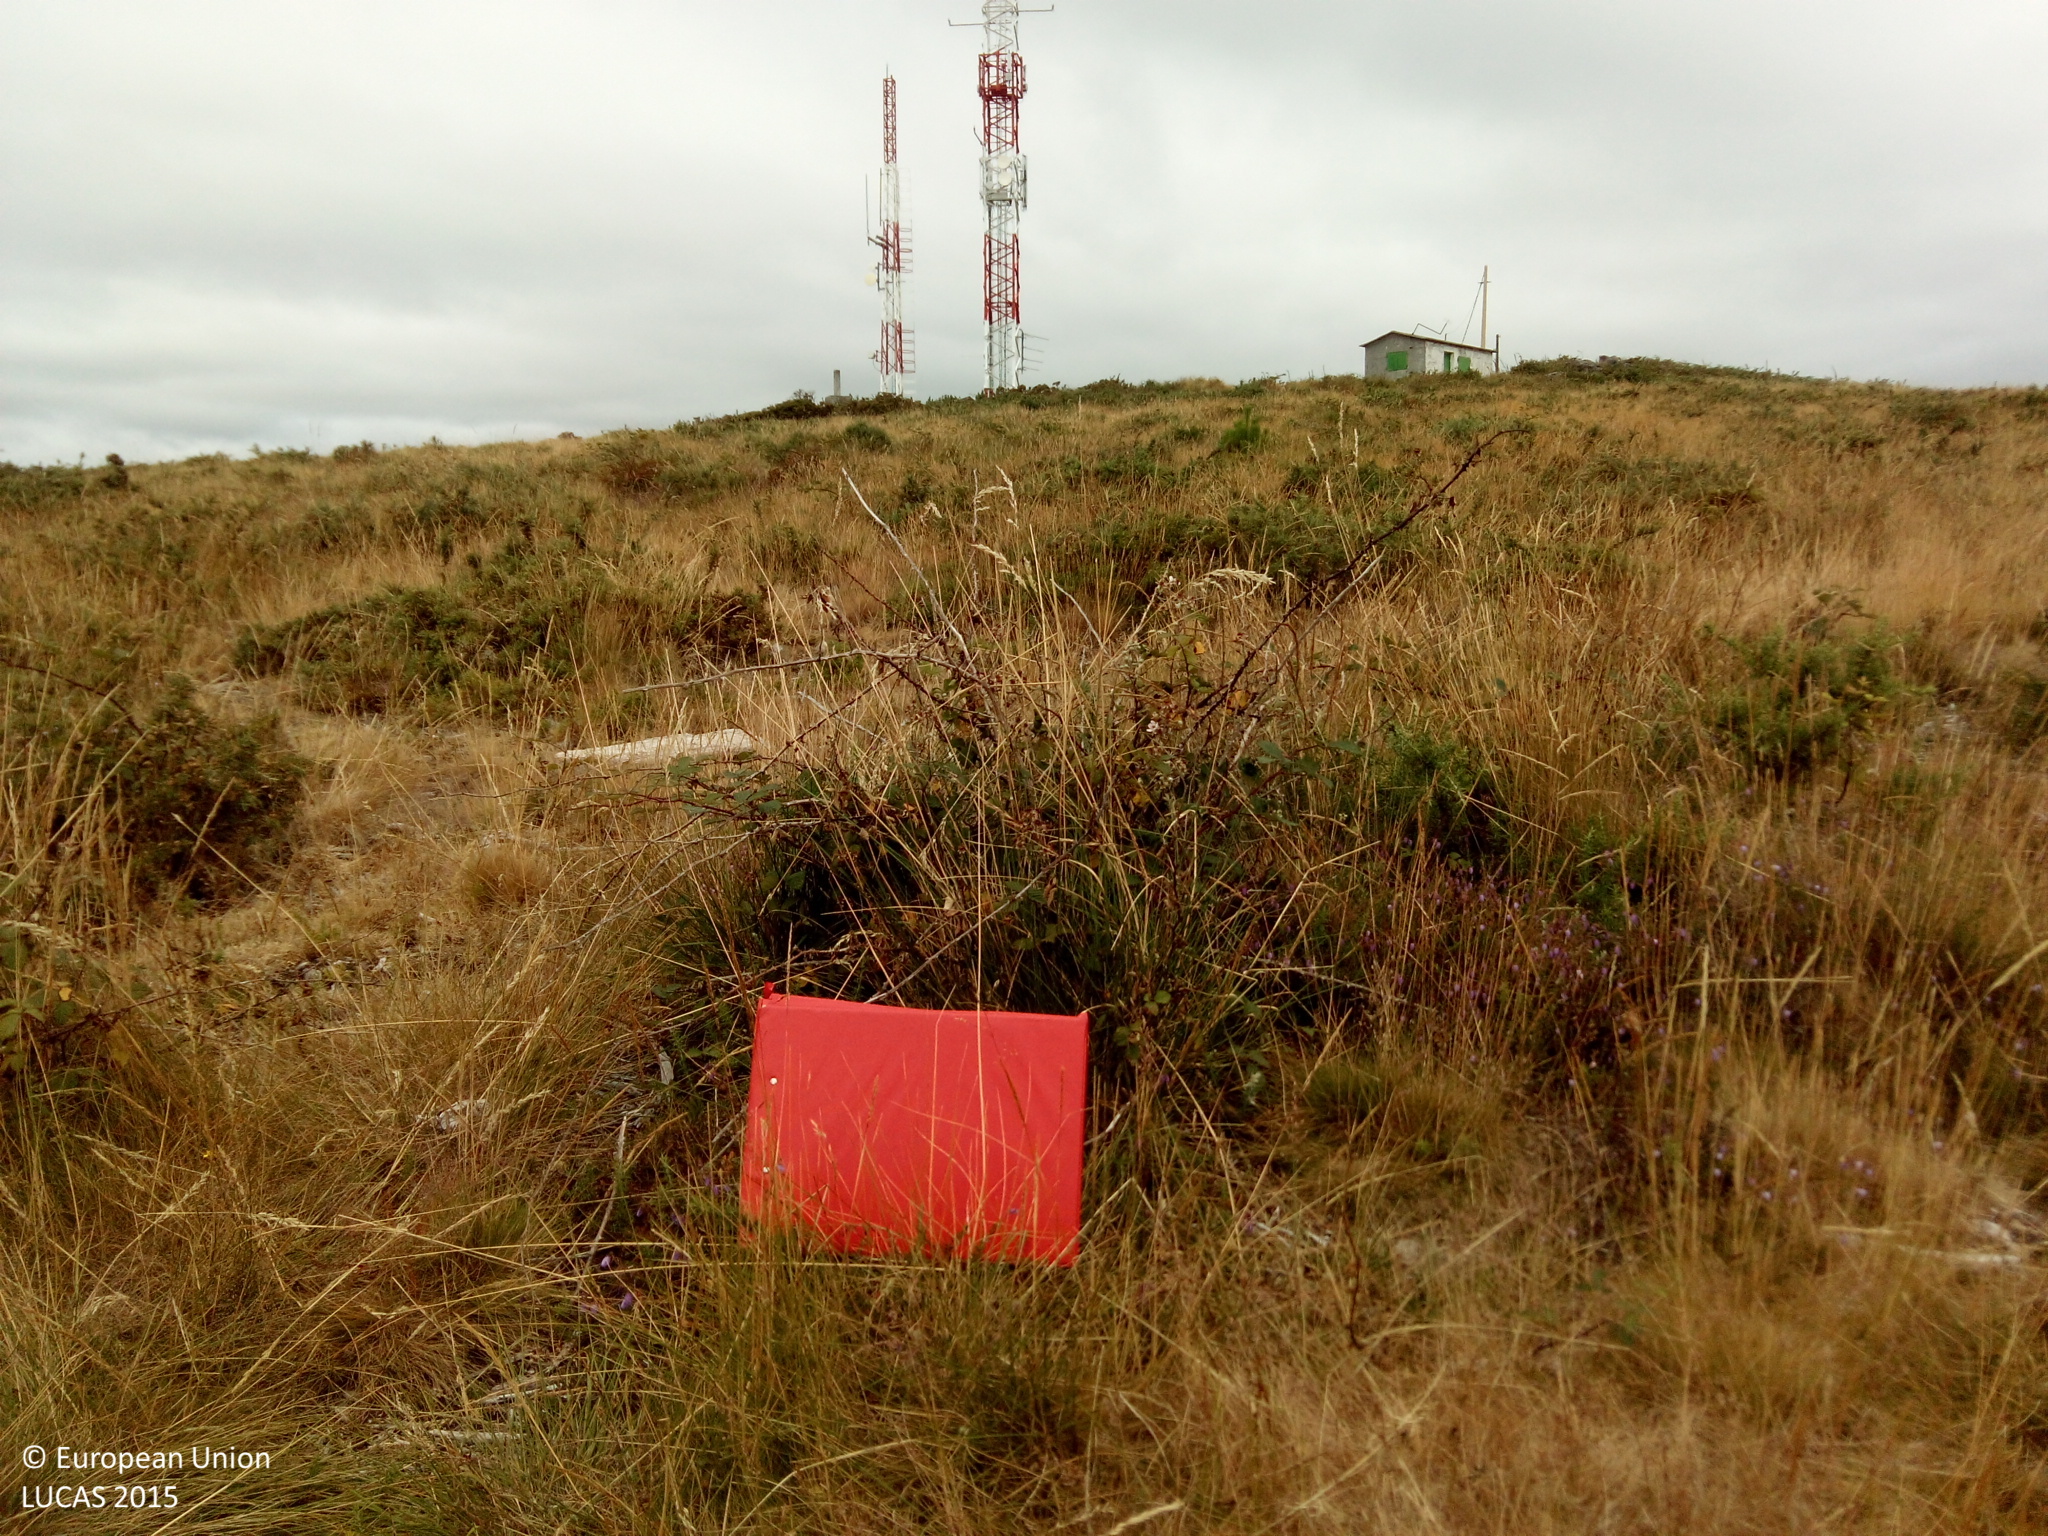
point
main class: Shrubland
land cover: Shrubland without tree cover
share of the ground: > 75 %
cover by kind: shrubs 100 %
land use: Semi-natural and natural areas not in use
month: July
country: ES
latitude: 42.5579
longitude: -8.4021
